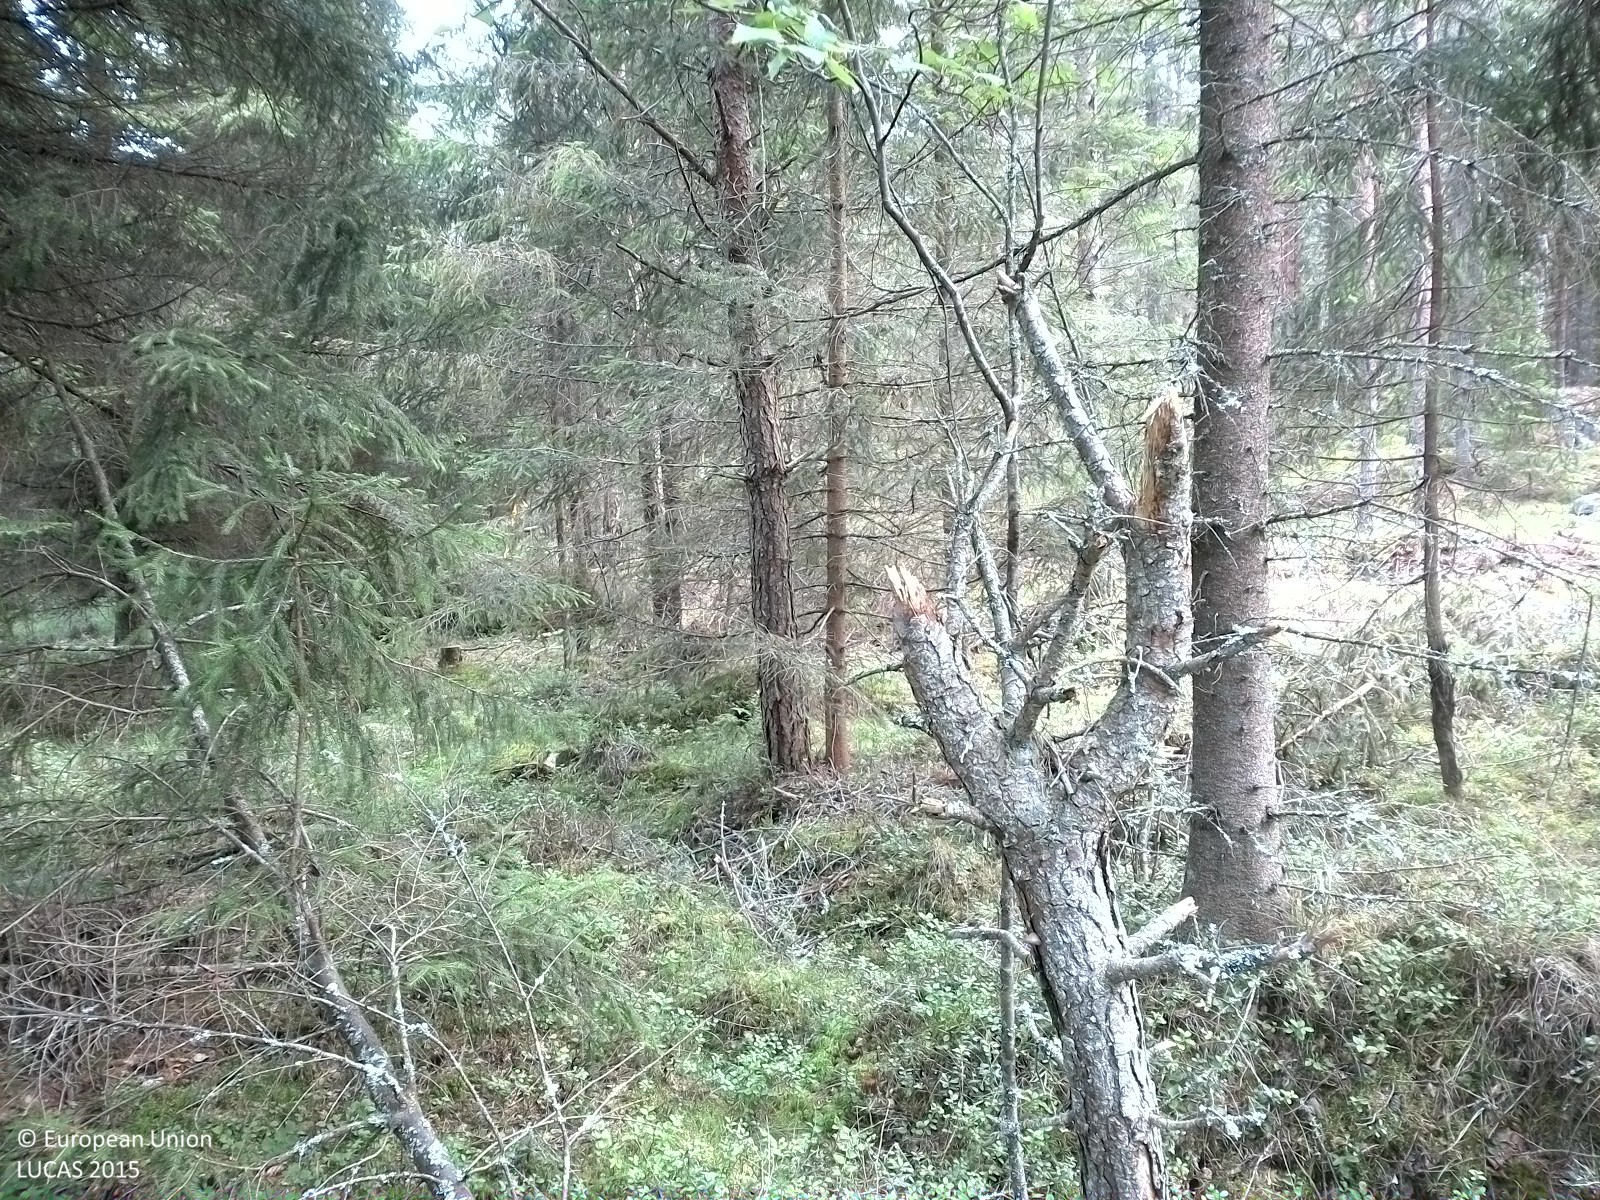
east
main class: Woodland
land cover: Pine dominated mixed woodland
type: boreal forest
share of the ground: 25 - 50 %
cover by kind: herbaceous plants 35 %, coniferous forest trees 25 %, lichens and mosses 20 %, broadleaved forest trees 15 %, shrubs 5 %
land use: Forestry
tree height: > 5 m
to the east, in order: Pine dominated mixed woodland; Tracks; Pine dominated coniferous woodland; Tracks; Pine dominated coniferous woodland; Tracks; Pine dominated coniferous woodland; Tracks; Other coniferous woodland; Tracks; Other coniferous woodland
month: August
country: SE
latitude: 58.9242
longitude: 15.3599
